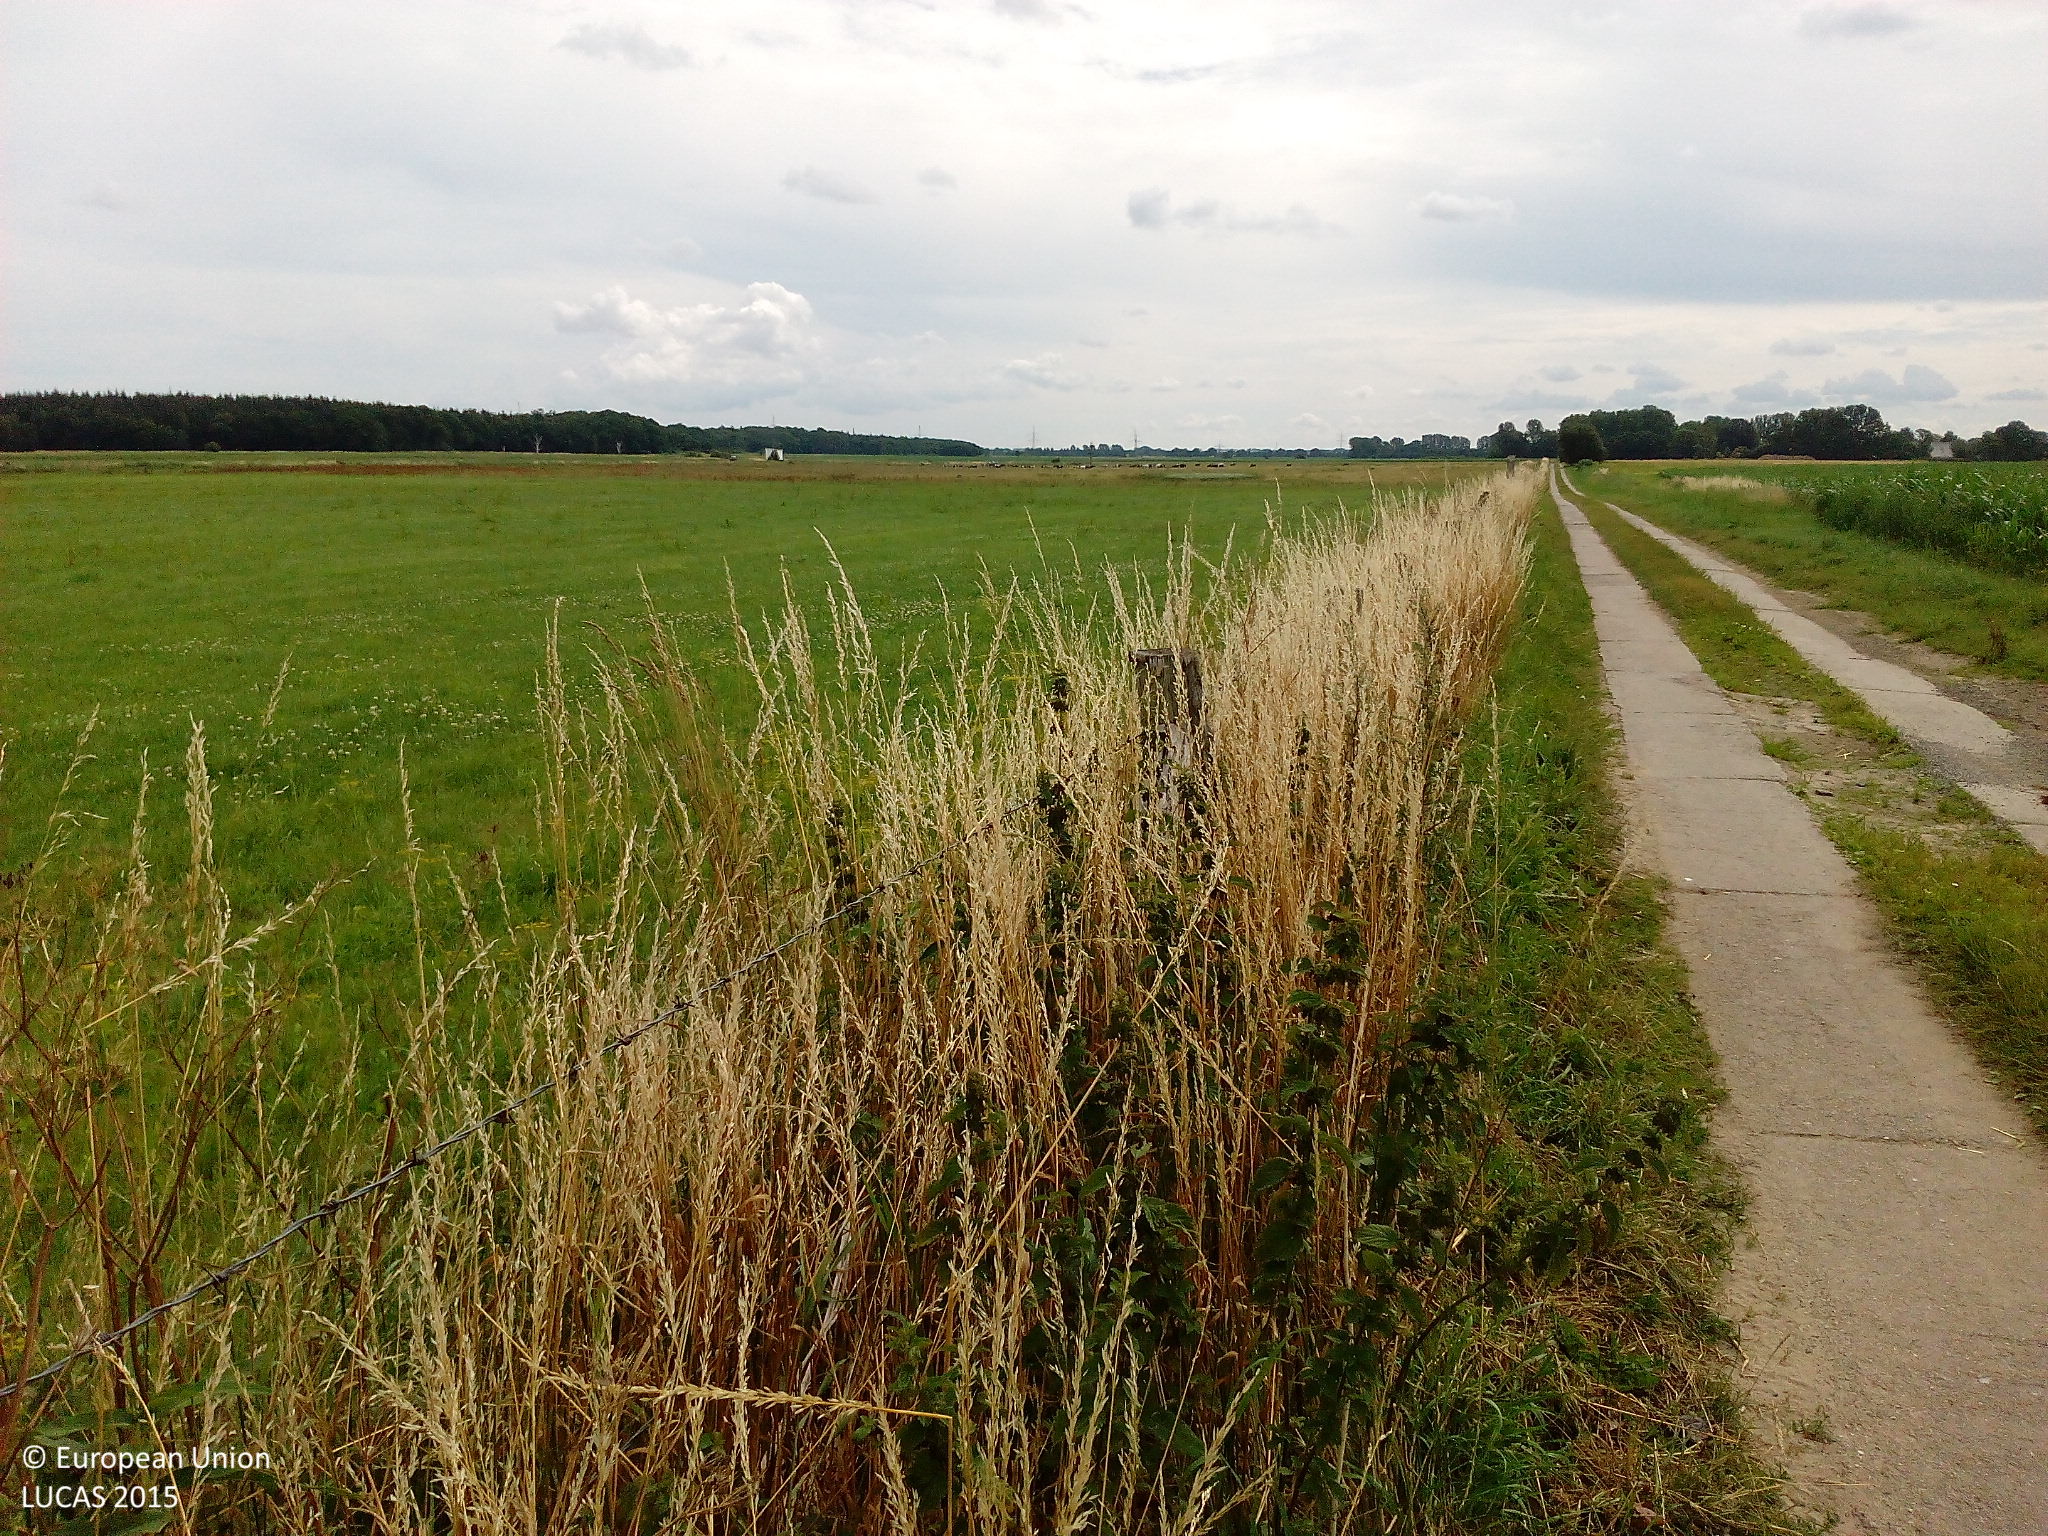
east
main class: Grassland
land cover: Grassland without tree/shrub cover
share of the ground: > 75 %
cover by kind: herbaceous plants 100 %
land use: Agriculture (excluding fallow land and kitchen gardens)
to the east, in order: Grassland without tree/shrub cover; Fences; Grassland without tree/shrub cover
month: July
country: DE
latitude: 54.0949
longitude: 13.2868
